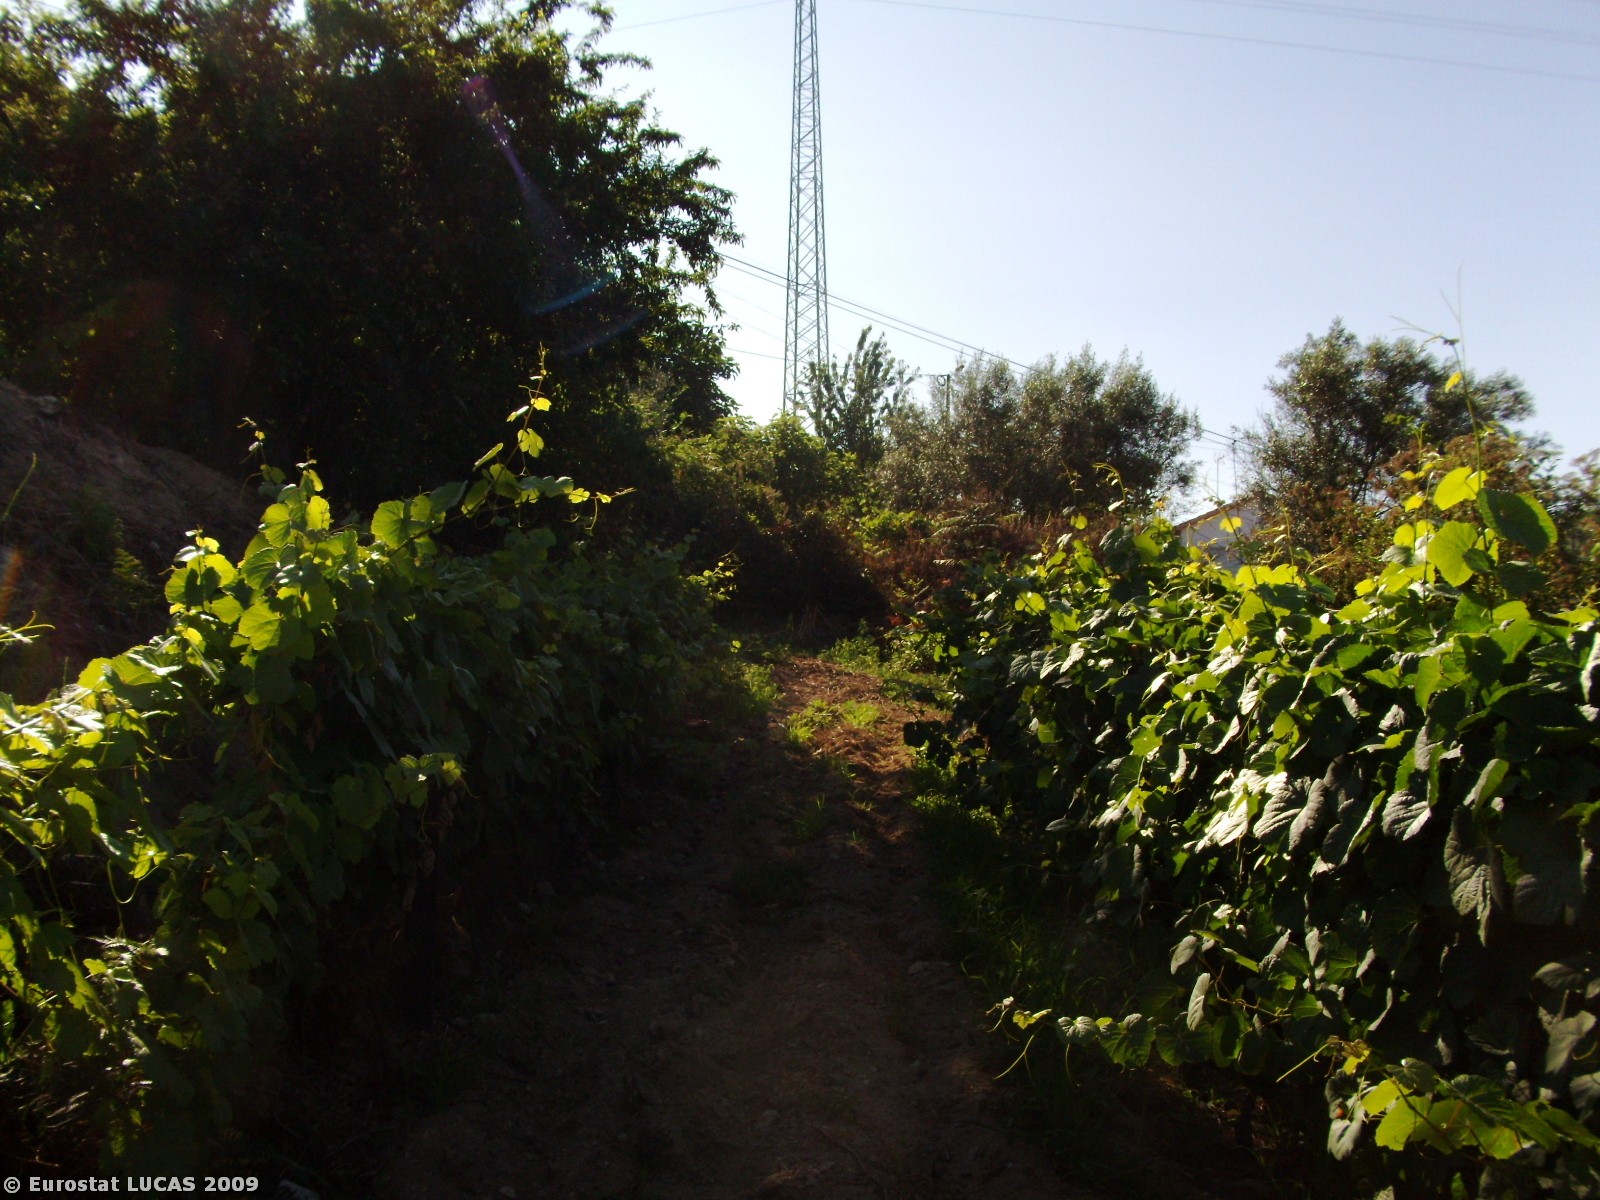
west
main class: Cropland
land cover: Vineyards
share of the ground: 25 - 50 %
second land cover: Bare land
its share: > 75 %
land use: Agriculture (excluding fallow land and kitchen gardens)
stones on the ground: < 10 %
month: July
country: PT
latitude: 41.0842
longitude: -7.7811
